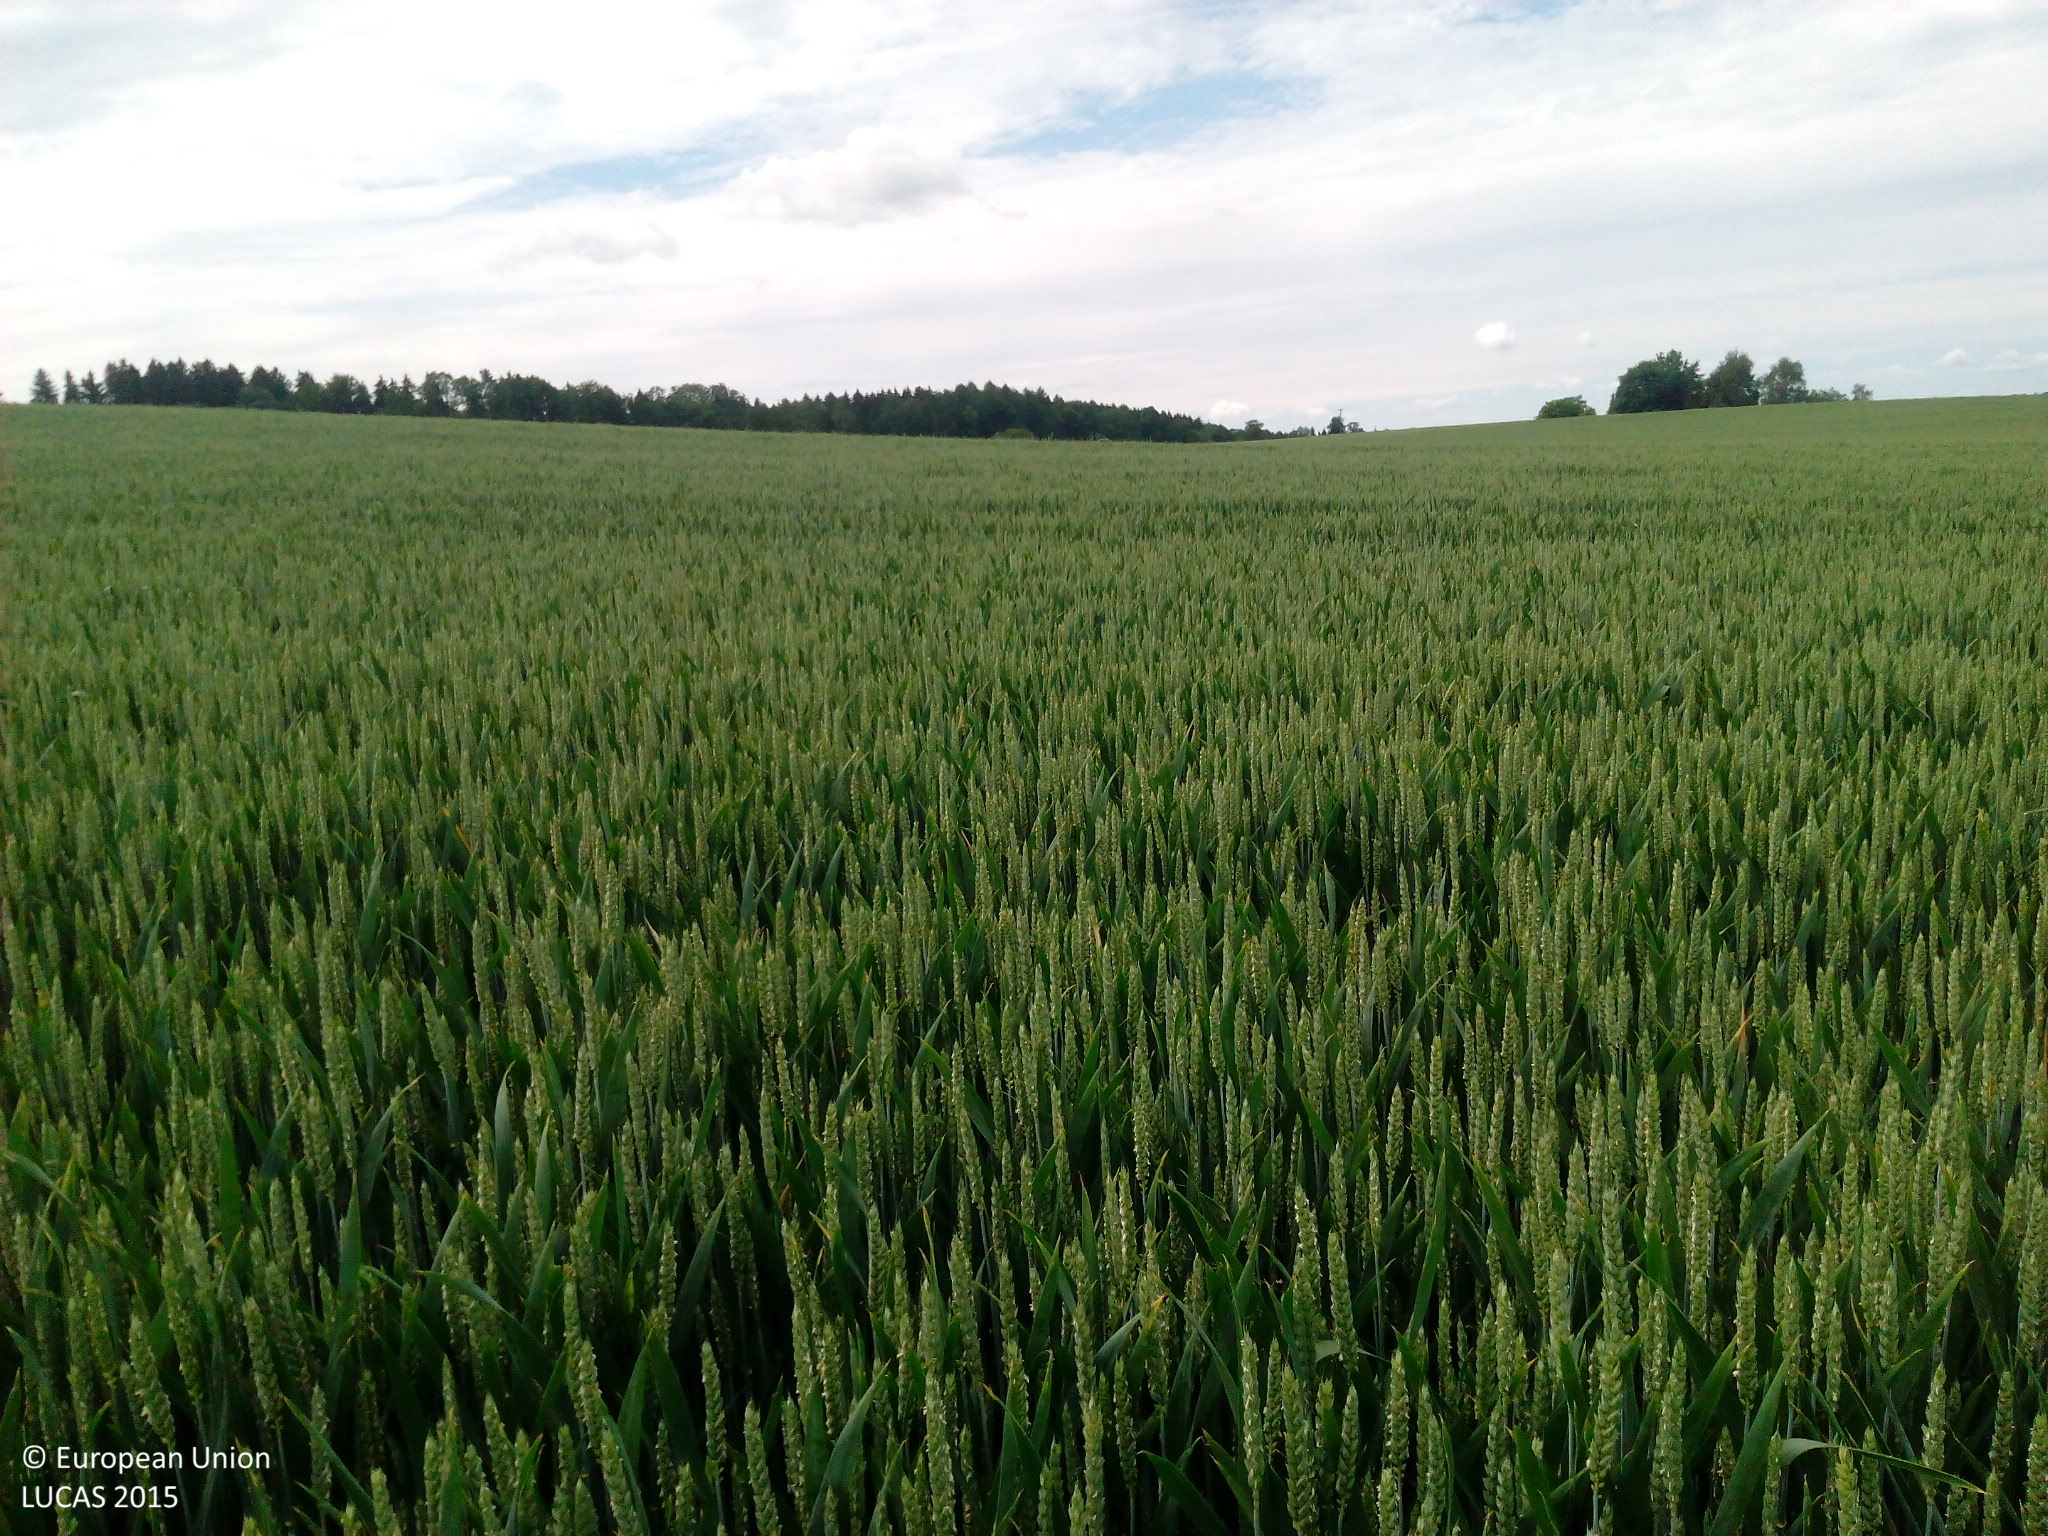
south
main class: Cropland
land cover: Common wheat
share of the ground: > 75 %
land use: Agriculture (excluding fallow land and kitchen gardens)
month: June
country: DE
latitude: 47.9170
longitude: 9.6390
